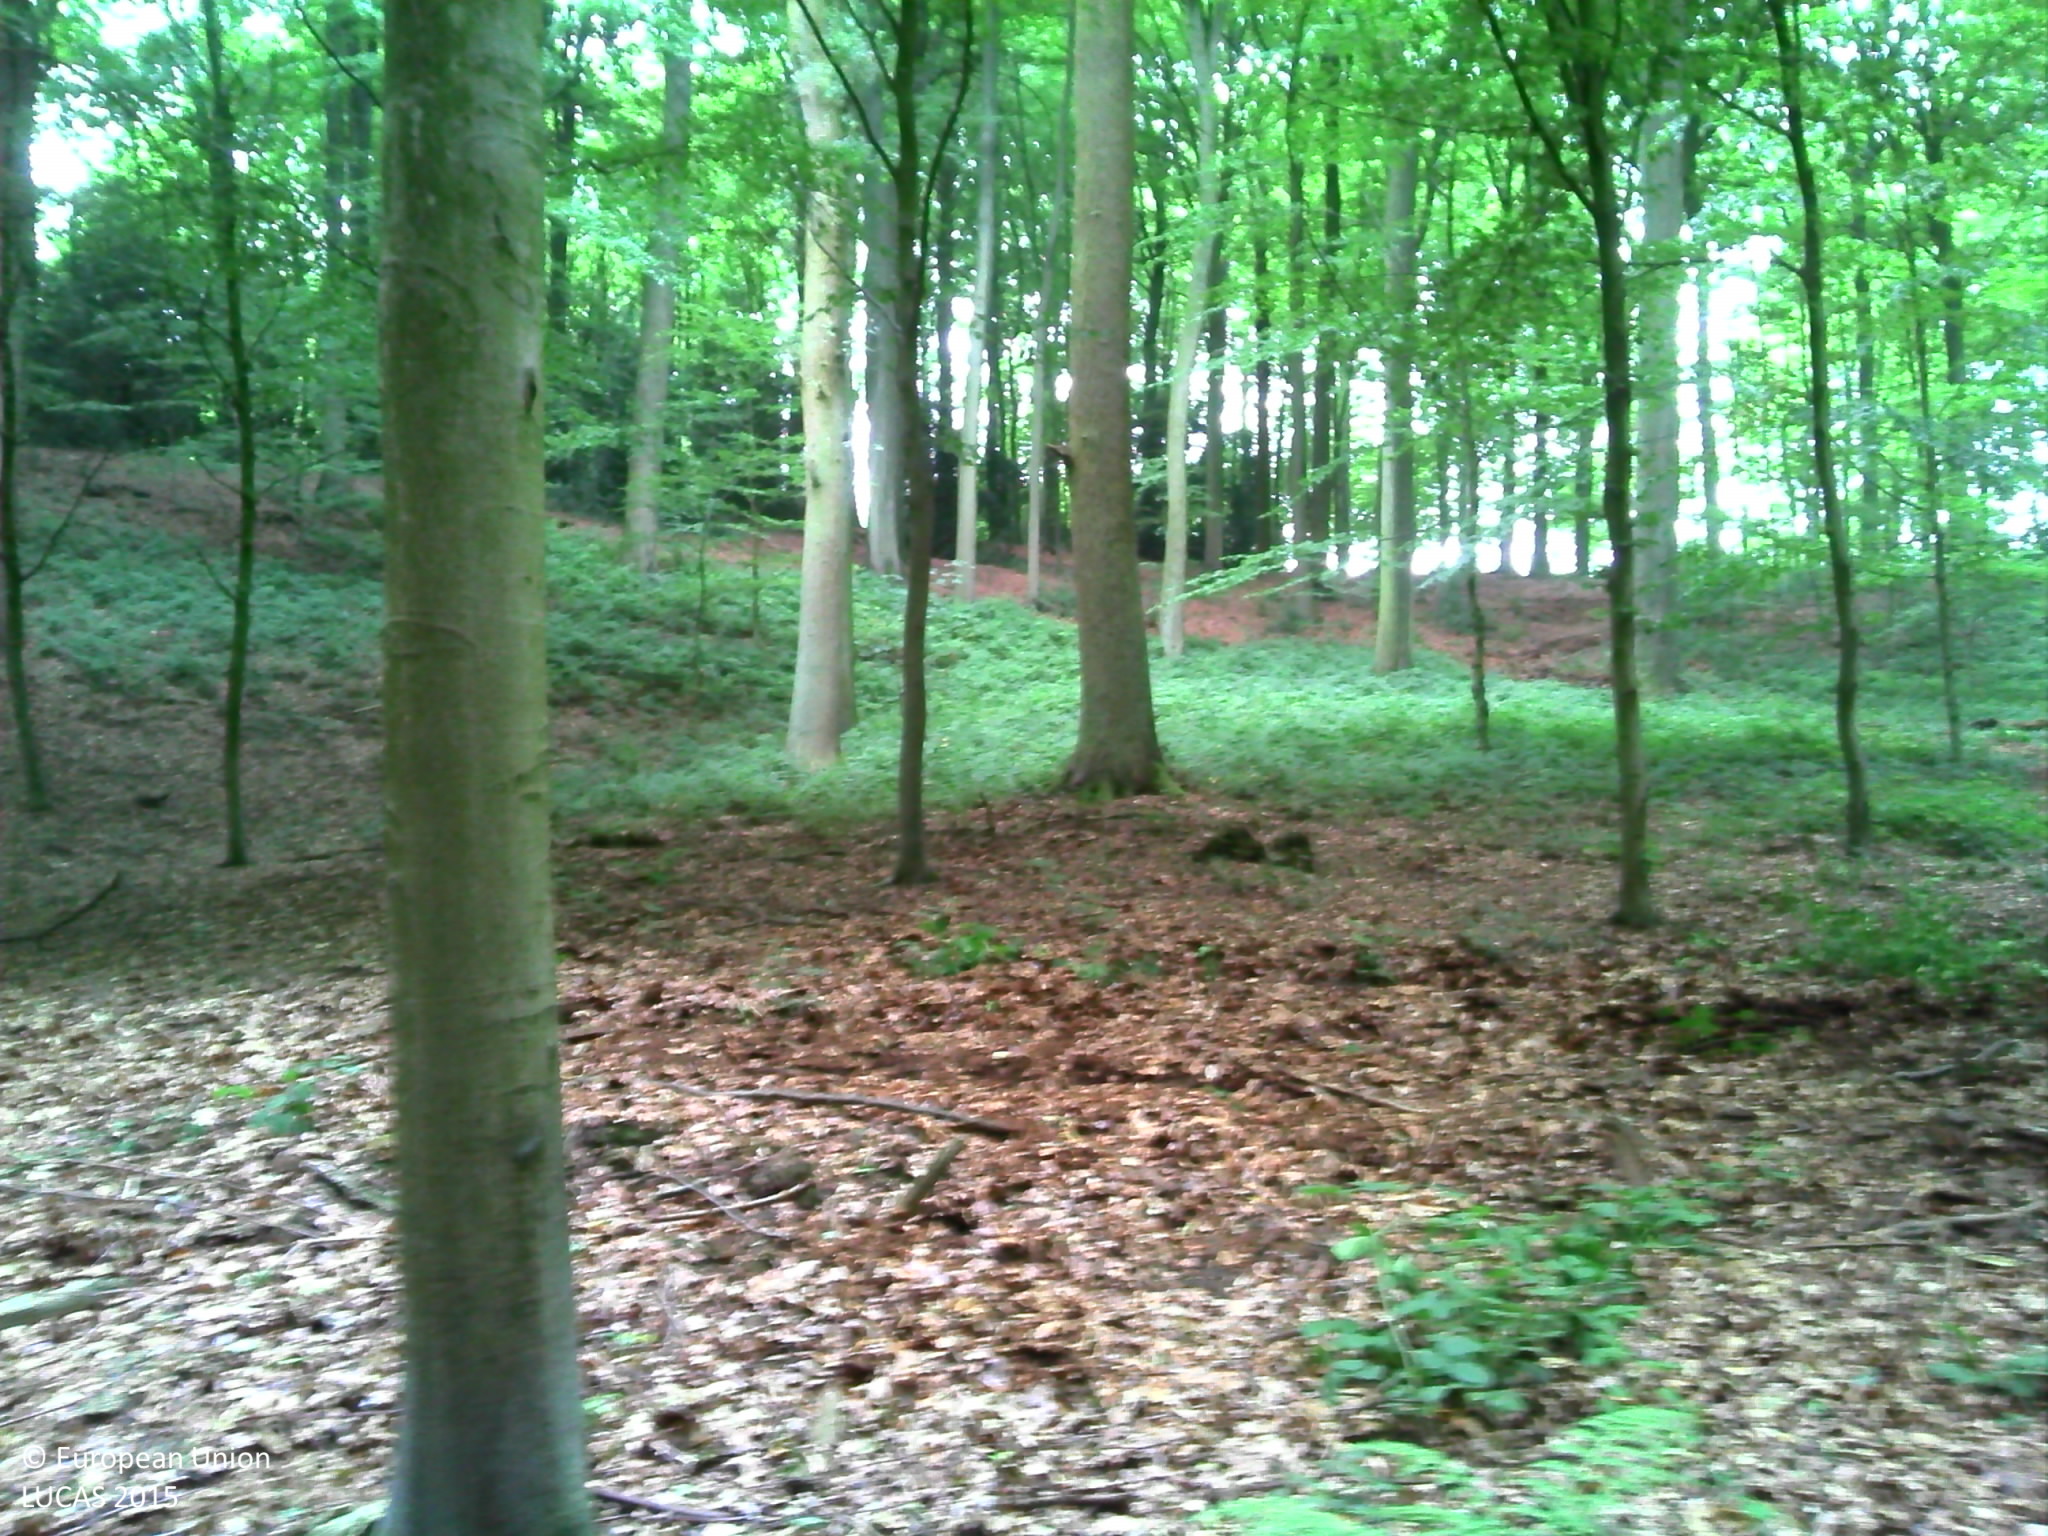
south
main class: Woodland
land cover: Broadleaved woodland
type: beech forest
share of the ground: > 75 %
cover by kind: broadleaved forest trees 90 %, shrubs 5 %, herbaceous plants 5 %
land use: Forestry
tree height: > 5 m
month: August
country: BE
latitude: 50.7098
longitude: 3.6343
